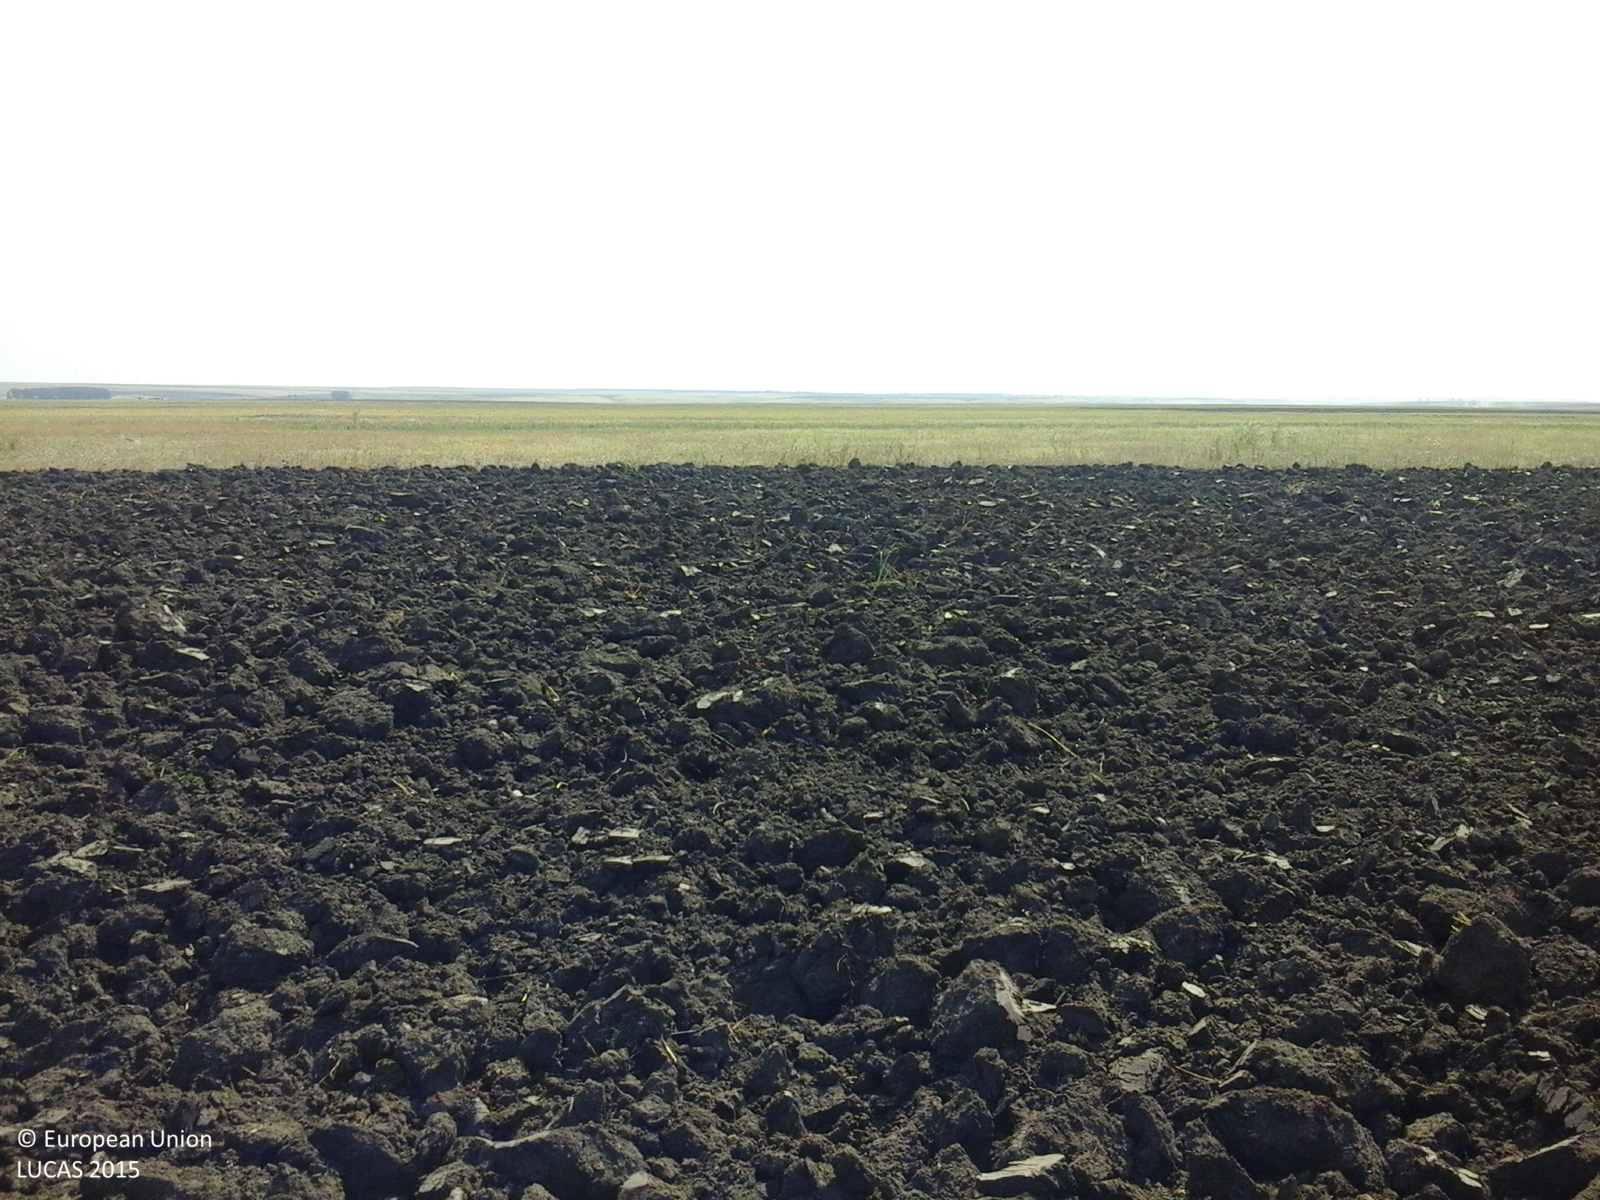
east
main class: Cropland
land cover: Durum wheat
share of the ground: < 10 %
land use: Agriculture (excluding fallow land and kitchen gardens)
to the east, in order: Durum wheat; Spontaneously vegetated surfaces; Tracks; Spontaneously vegetated surfaces; Common wheat
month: August
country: RO
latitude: 44.1587
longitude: 23.2129
